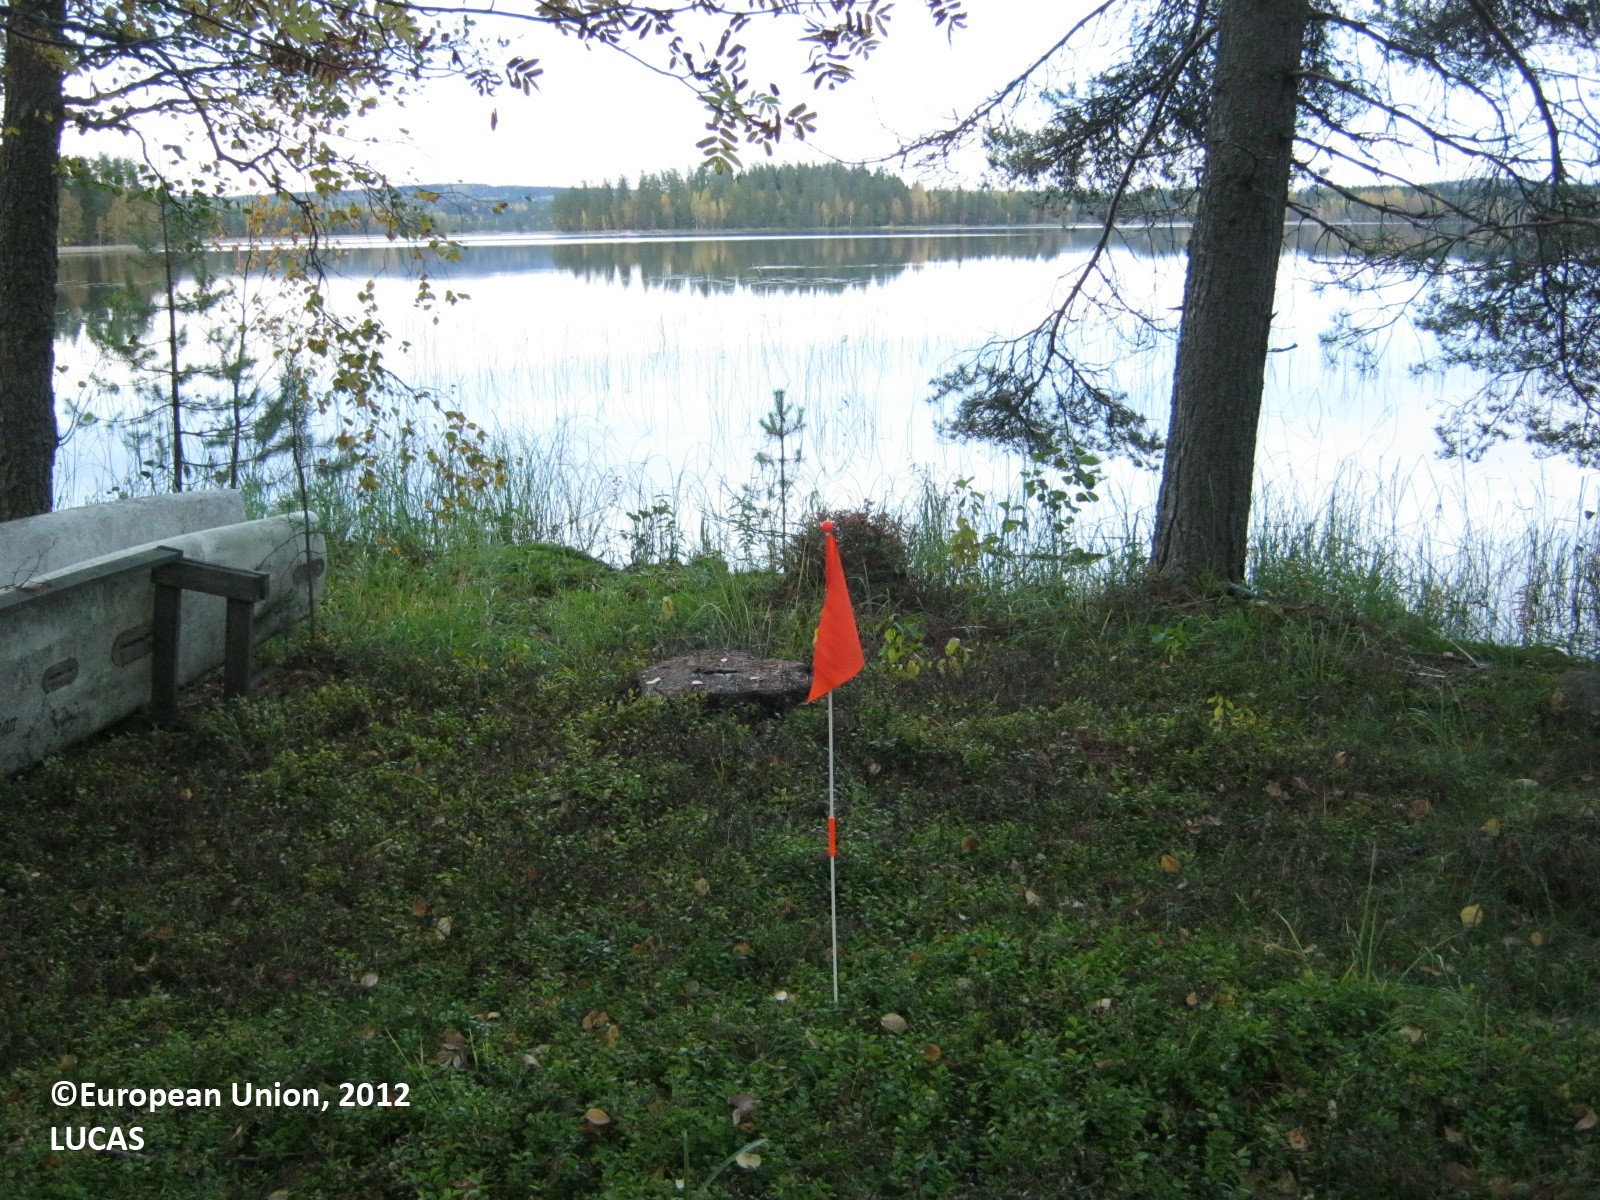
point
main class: Woodland
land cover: Other mixed woodland
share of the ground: 25 - 50 %
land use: Residential
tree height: > 5 m
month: September
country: FI
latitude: 62.3283
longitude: 28.7617
